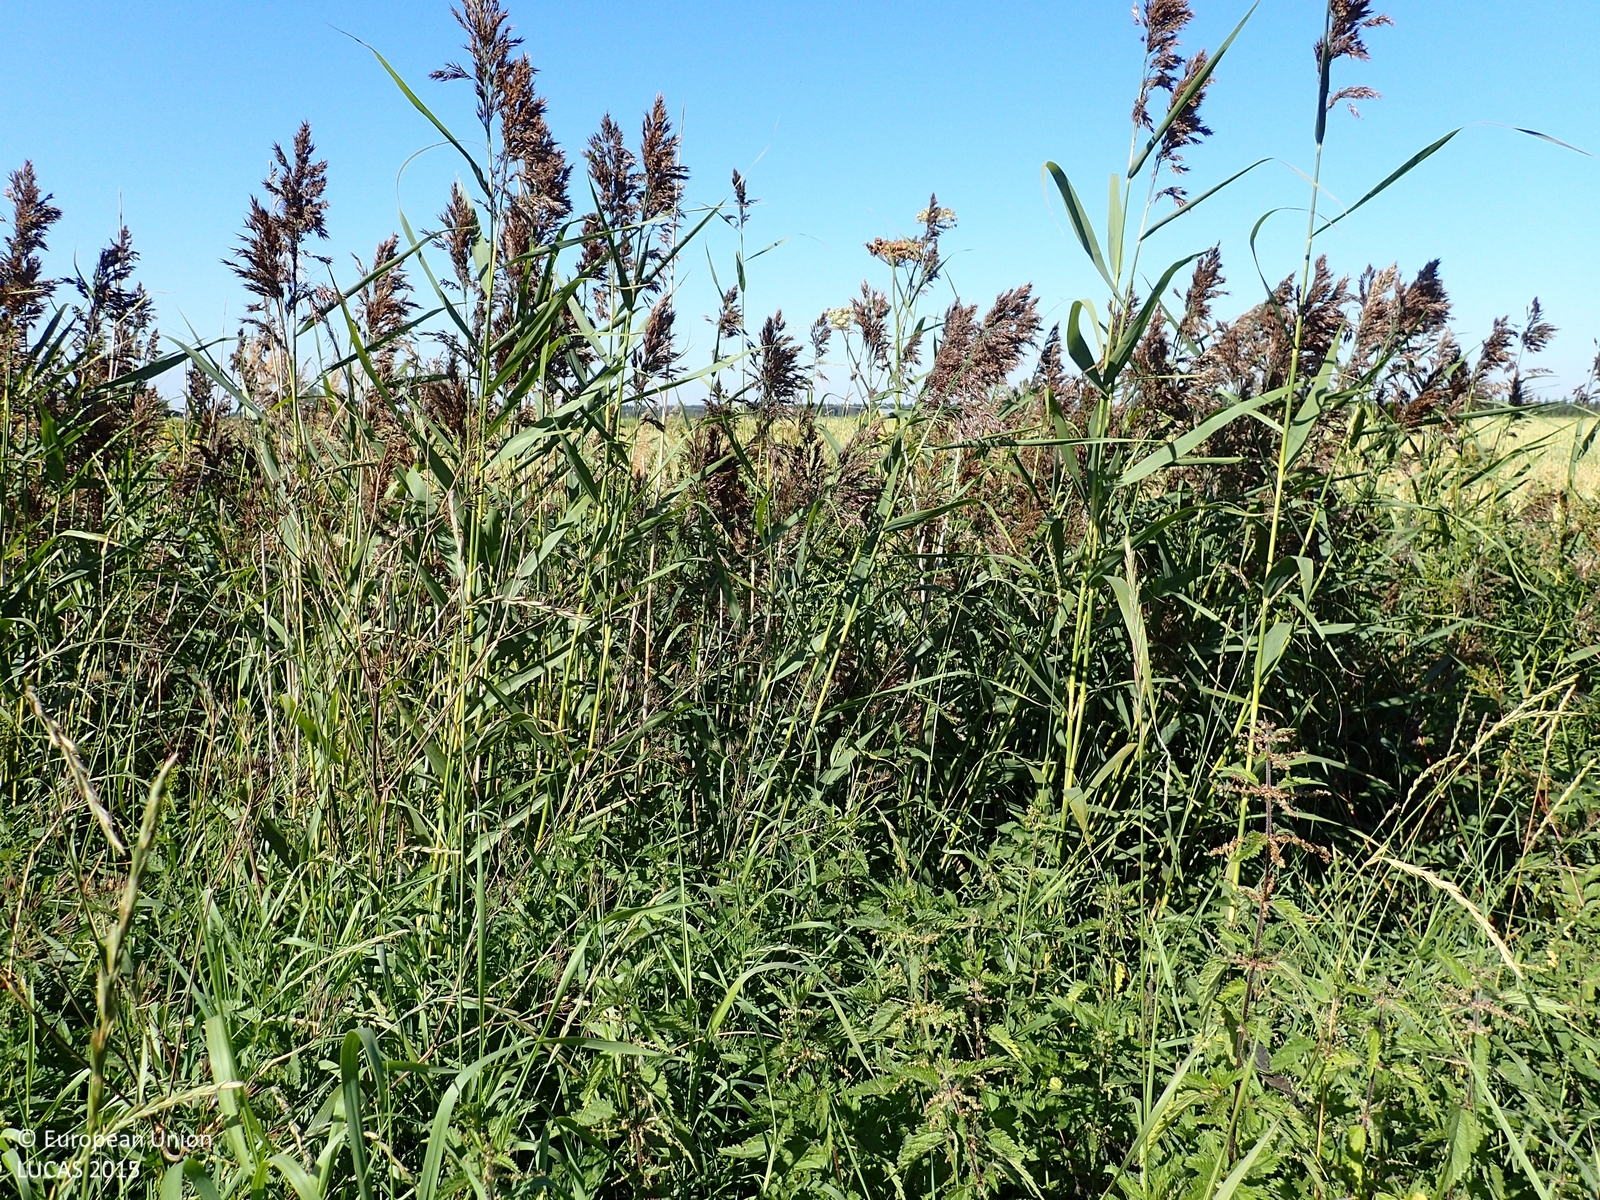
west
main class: Cropland
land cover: Common wheat
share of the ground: > 75 %
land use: Agriculture (excluding fallow land and kitchen gardens)
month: August
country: FI
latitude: 62.4652
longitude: 21.6992
